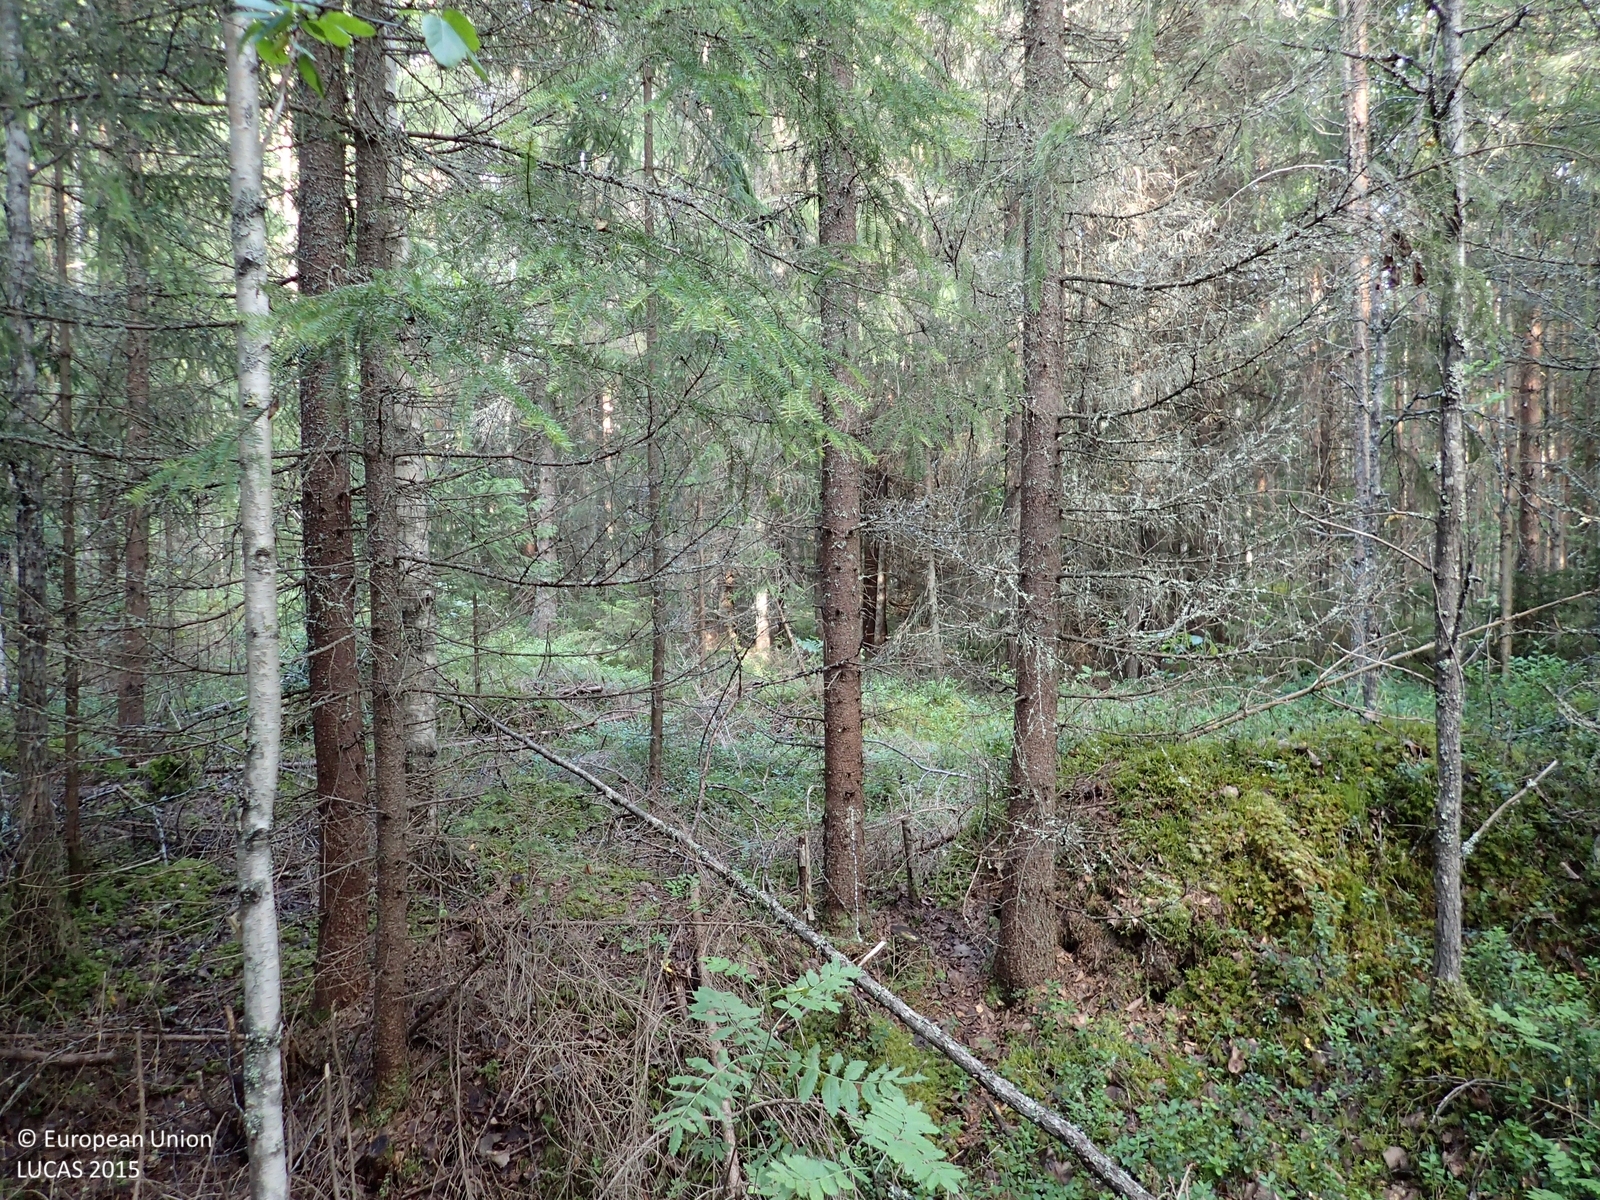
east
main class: Woodland
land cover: Spruce dominated mixed woodland
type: boreal forest
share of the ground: > 75 %
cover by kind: coniferous forest trees 60 %, broadleaved forest trees 20 %, shrubs 15 %, lichens and mosses 5 %
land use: Forestry
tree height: > 5 m
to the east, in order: Spruce dominated mixed woodland; Other mixed woodland; Spruce dominated mixed woodland; Tracks; Spruce dominated mixed woodland
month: July
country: FI
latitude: 62.9554
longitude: 21.9719
